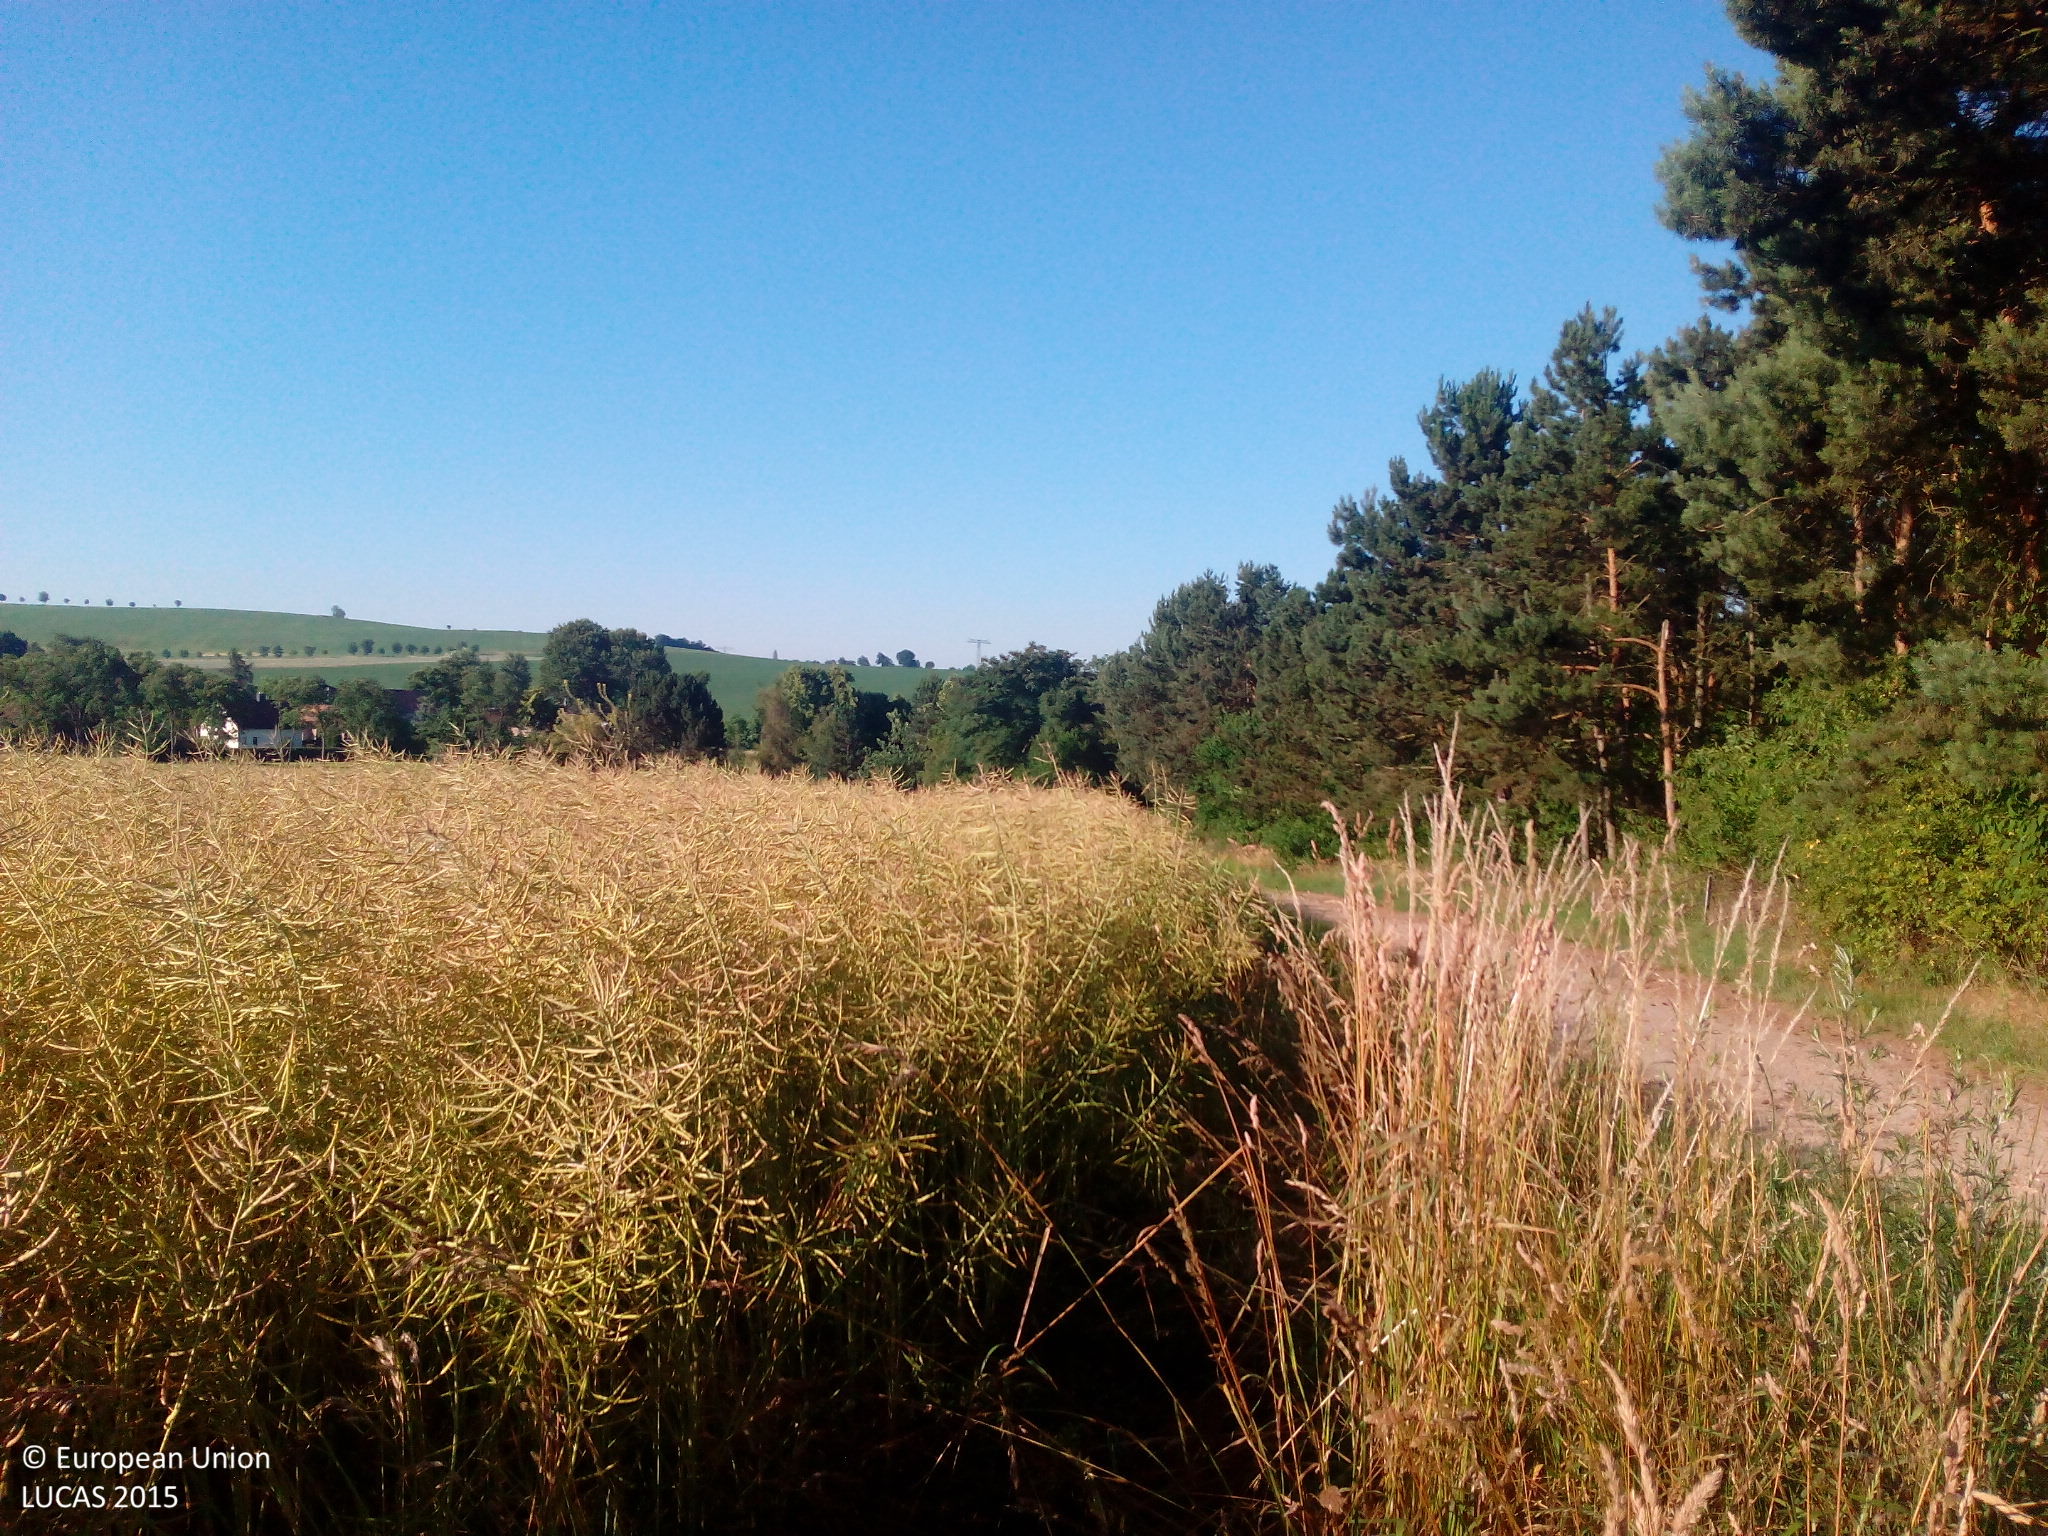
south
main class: Cropland
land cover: Rape and turnip rape
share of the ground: > 75 %
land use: Agriculture (excluding fallow land and kitchen gardens)
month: July
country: DE
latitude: 51.3652
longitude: 13.1169
